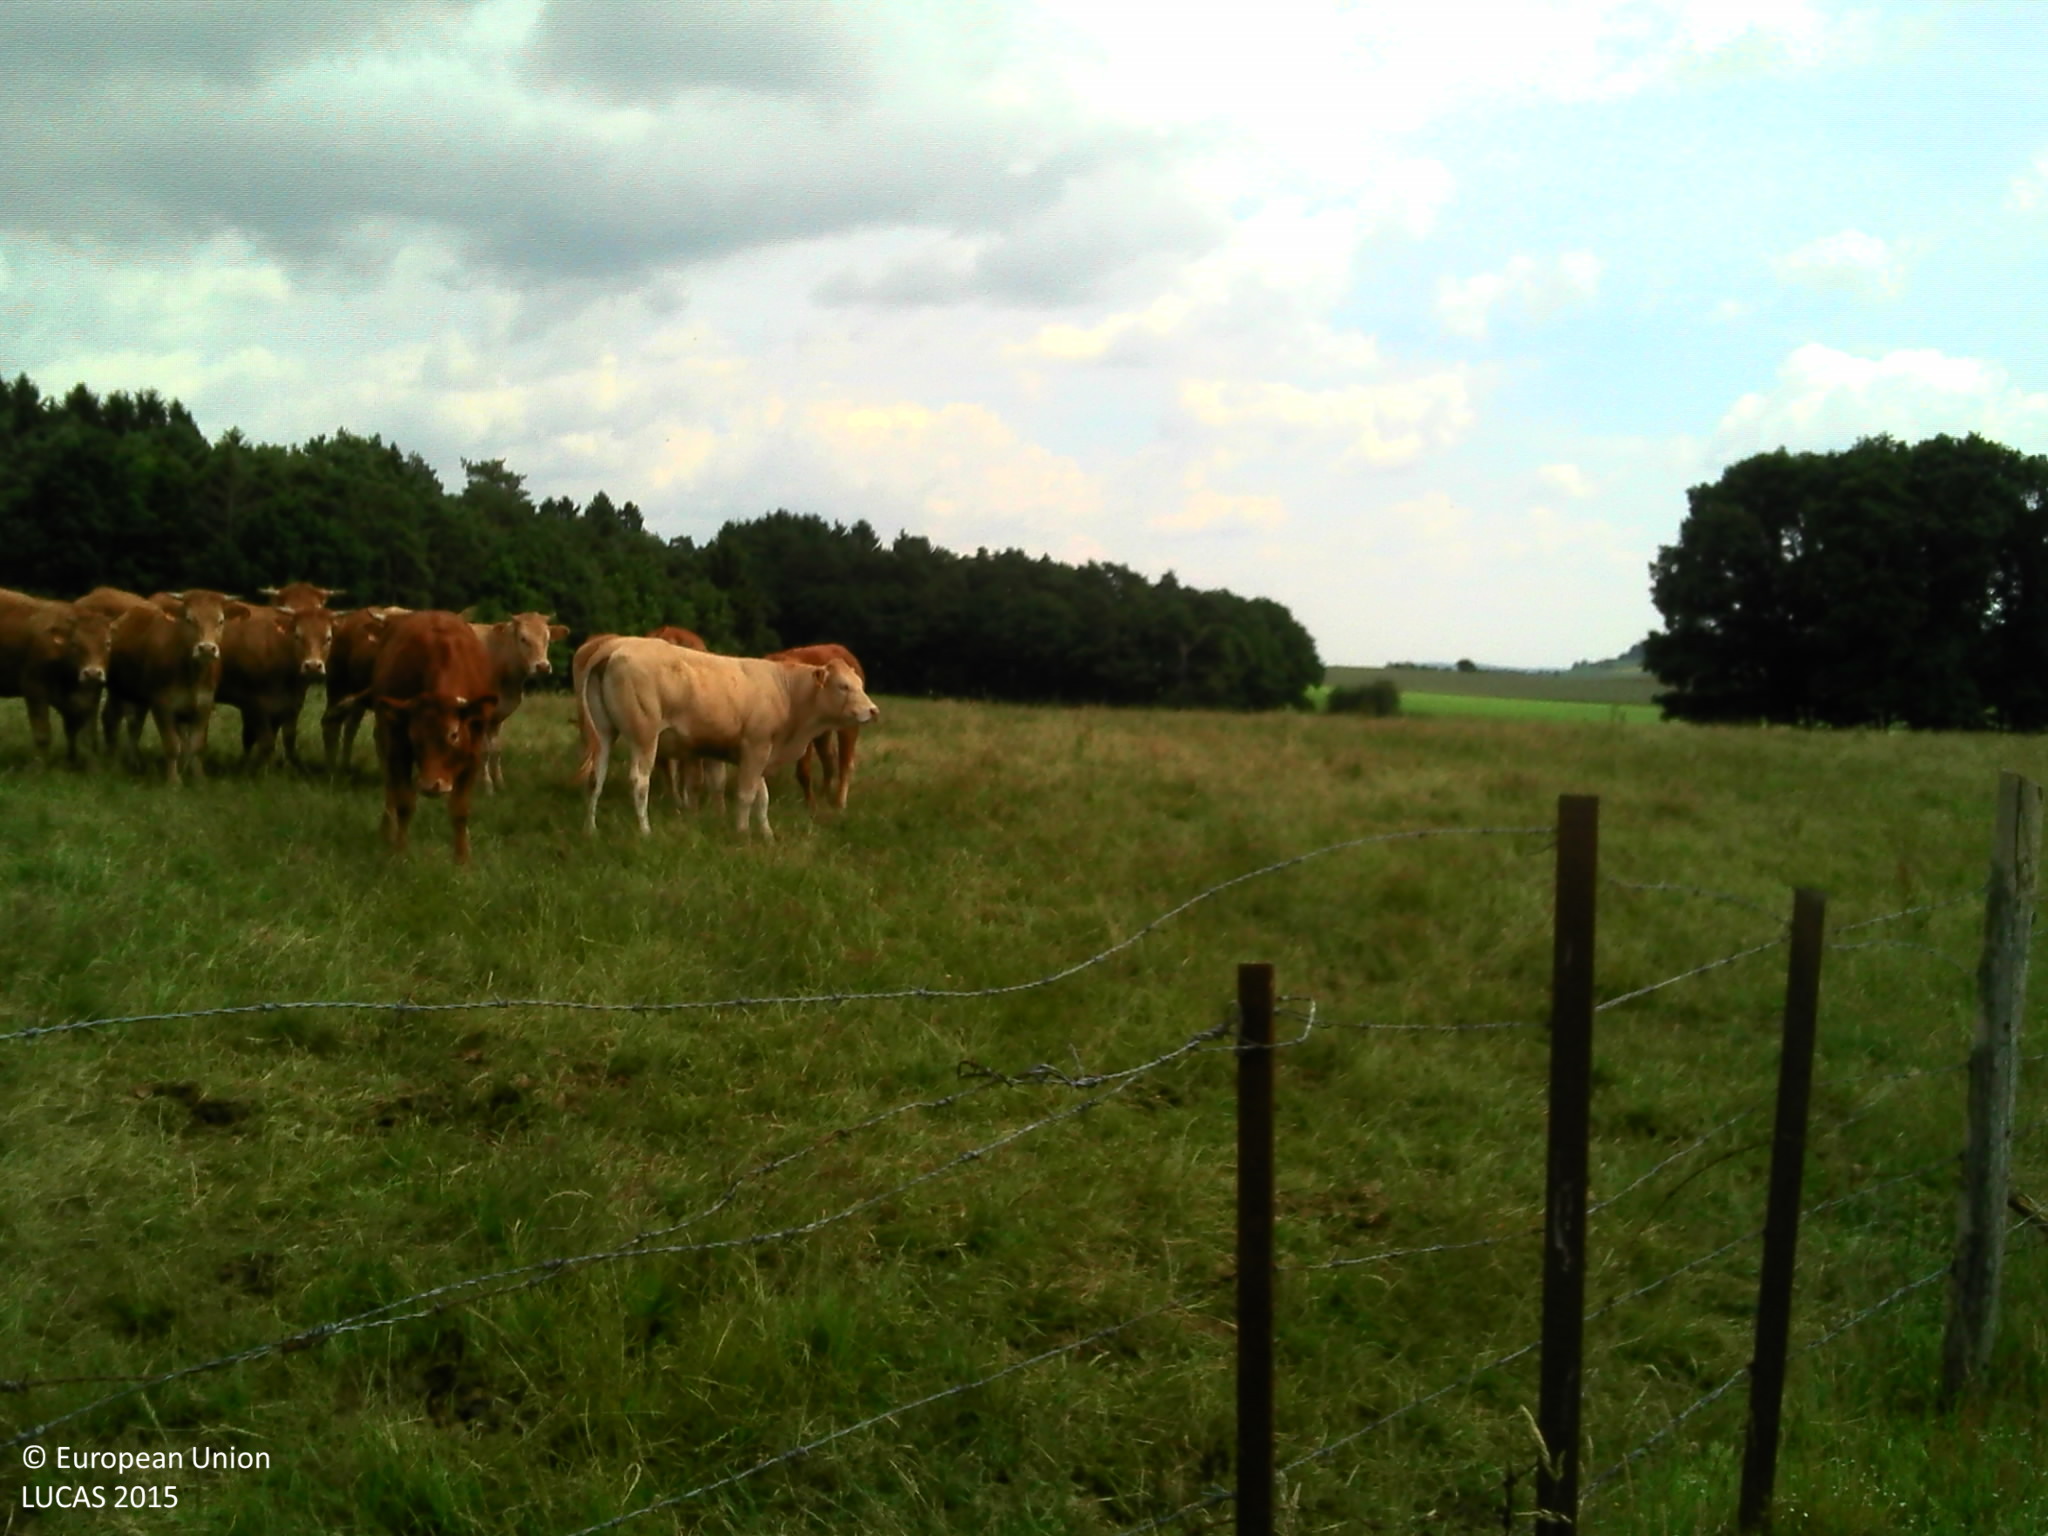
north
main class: Grassland
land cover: Grassland without tree/shrub cover
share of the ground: > 75 %
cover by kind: herbaceous plants 100 %
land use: Agriculture (excluding fallow land and kitchen gardens)
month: June
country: LU
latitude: 49.8443
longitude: 6.0081
